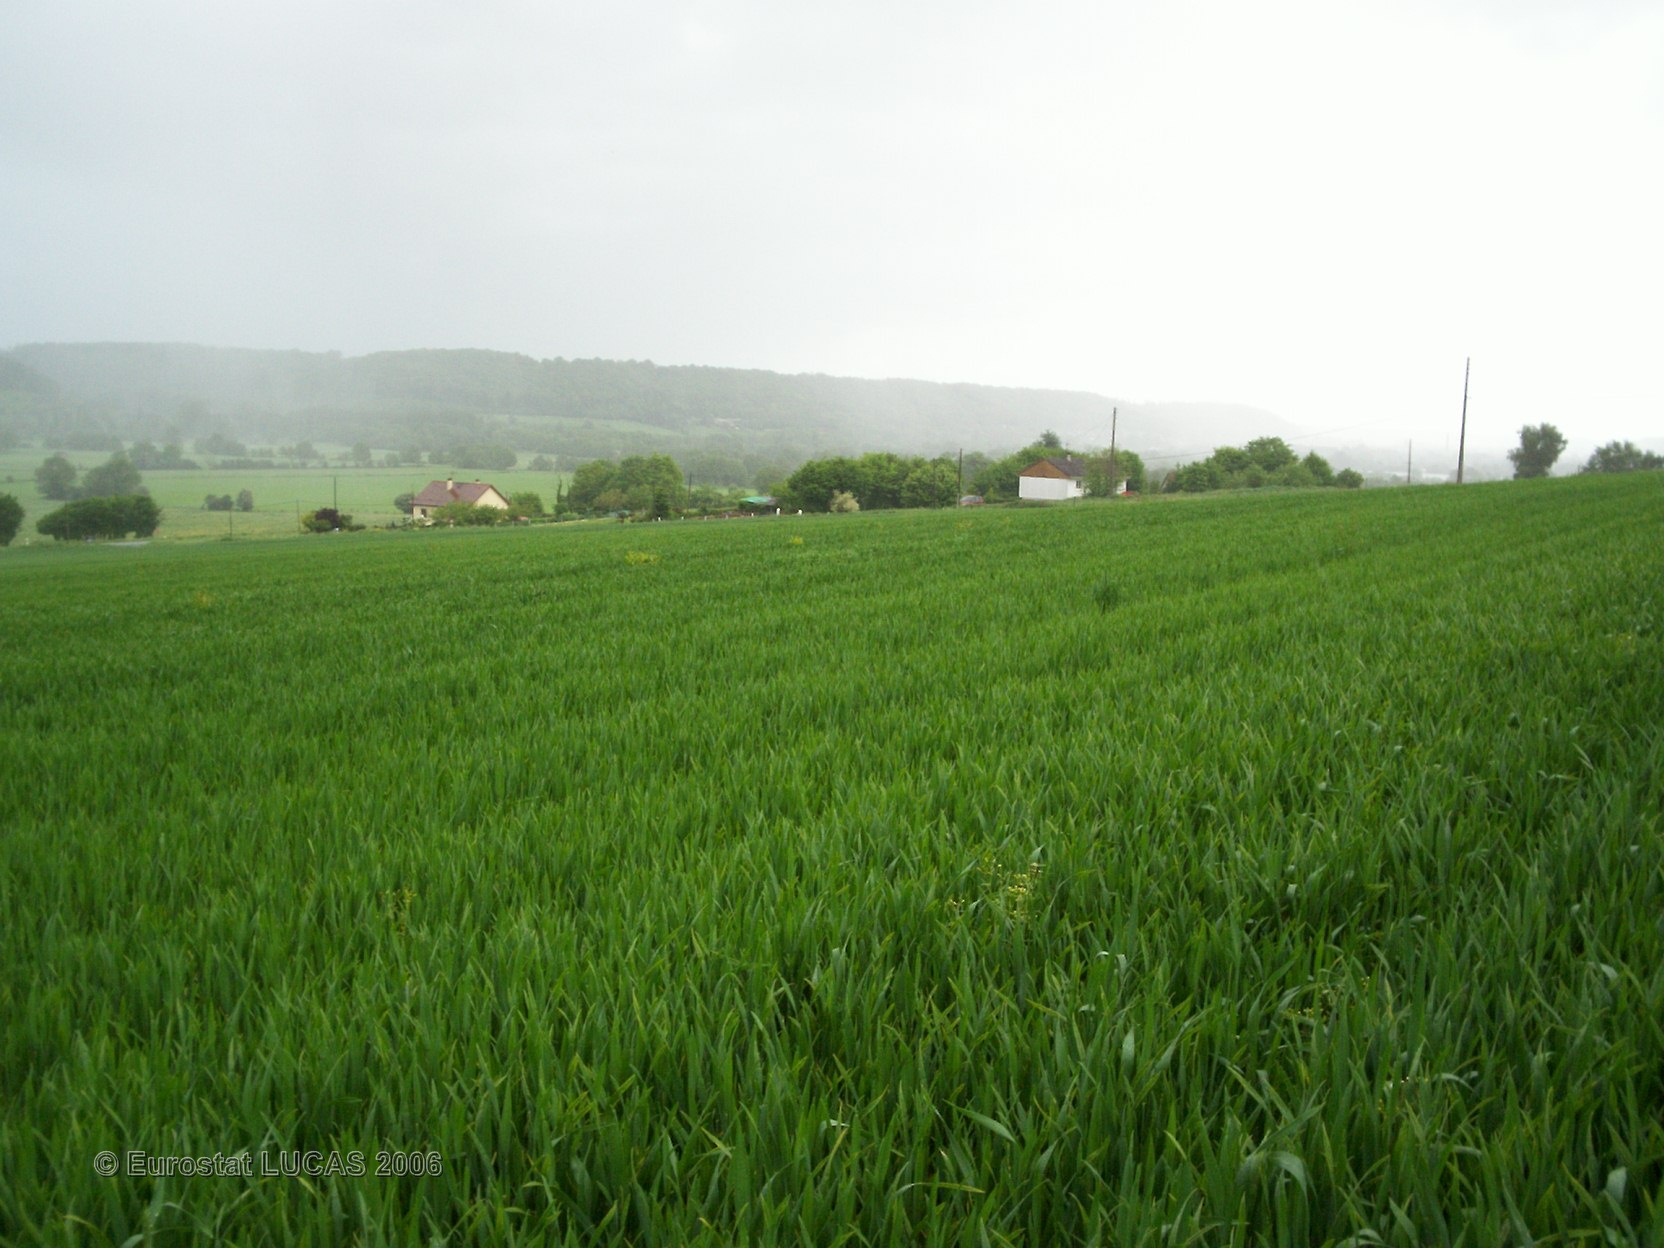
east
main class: Cropland
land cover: Common wheat
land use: Agriculture (excluding fallow land and kitchen gardens)
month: May
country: FR
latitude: 49.3666
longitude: 0.4577
